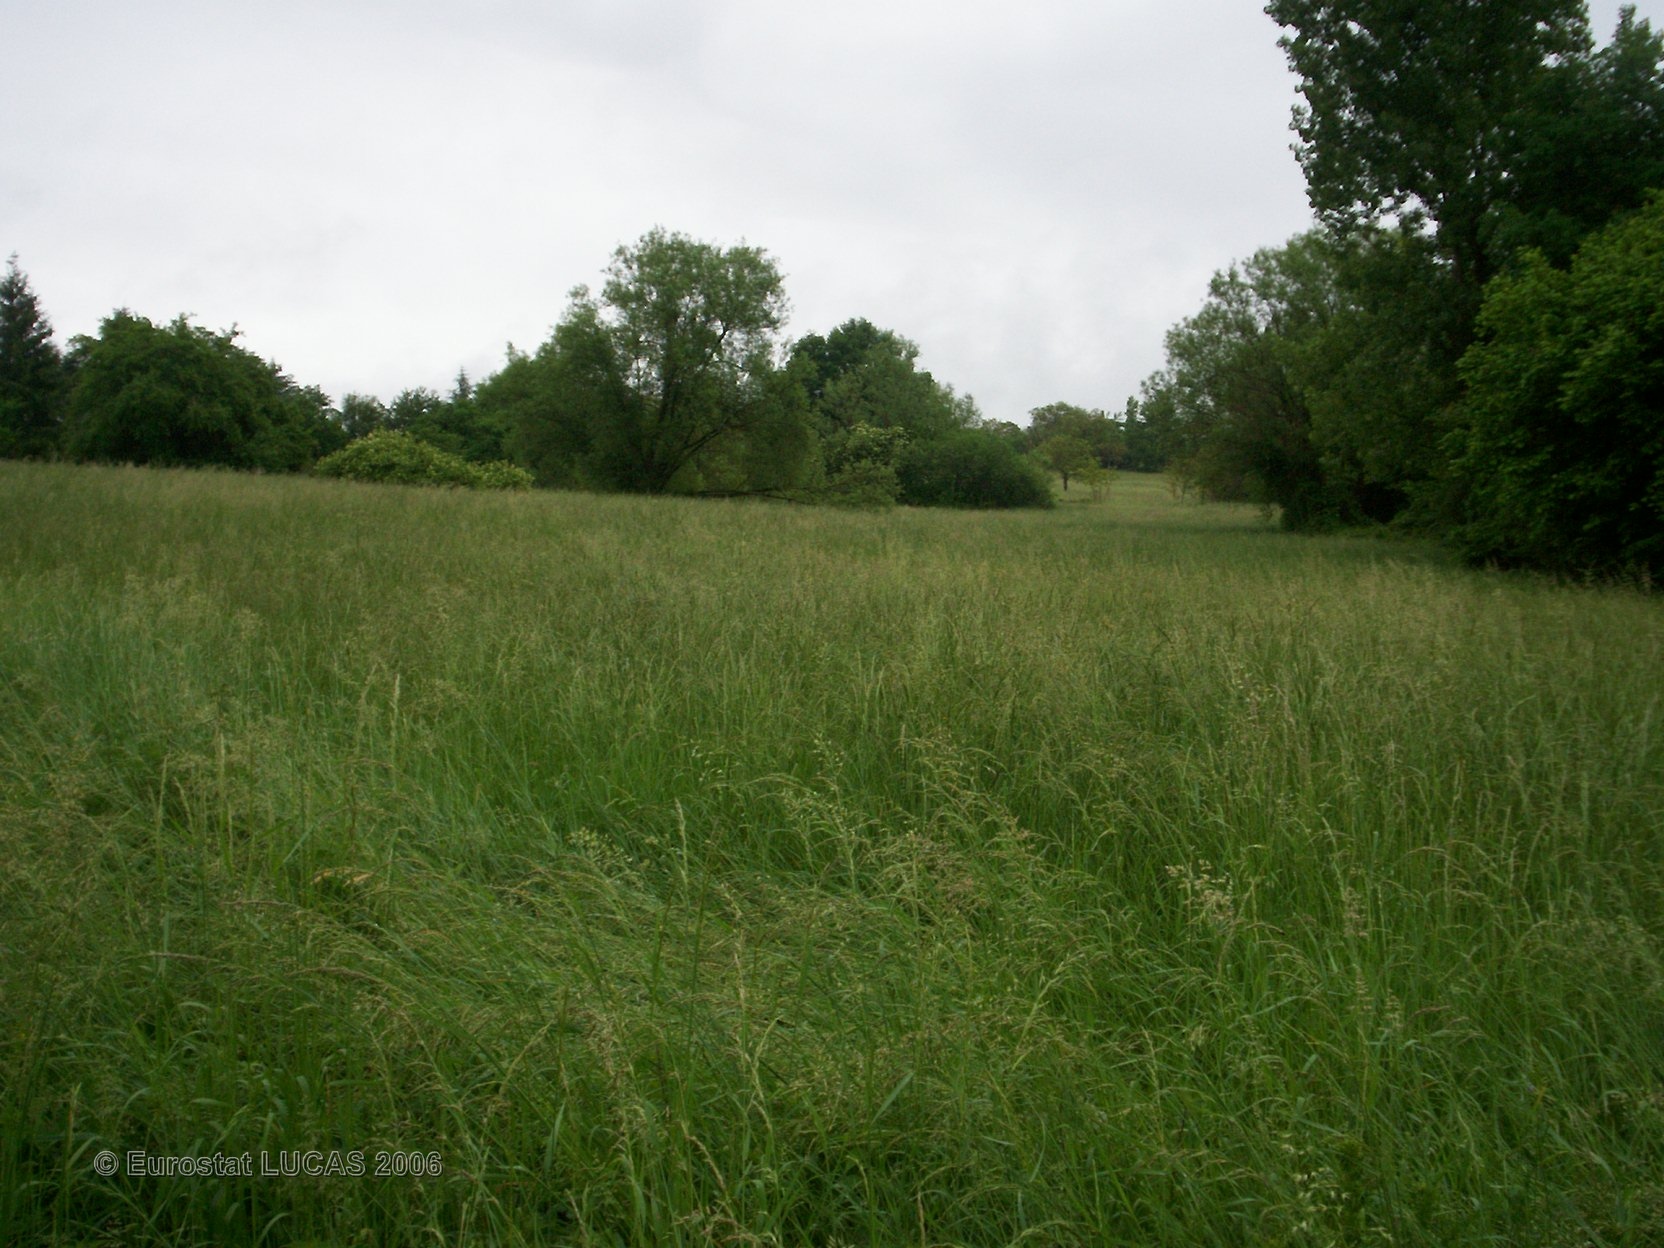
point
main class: Grassland
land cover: Grassland with sparse tree/shrub cover
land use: Agriculture (excluding fallow land and kitchen gardens)
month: May
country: FR
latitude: 44.7339
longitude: 1.3718
